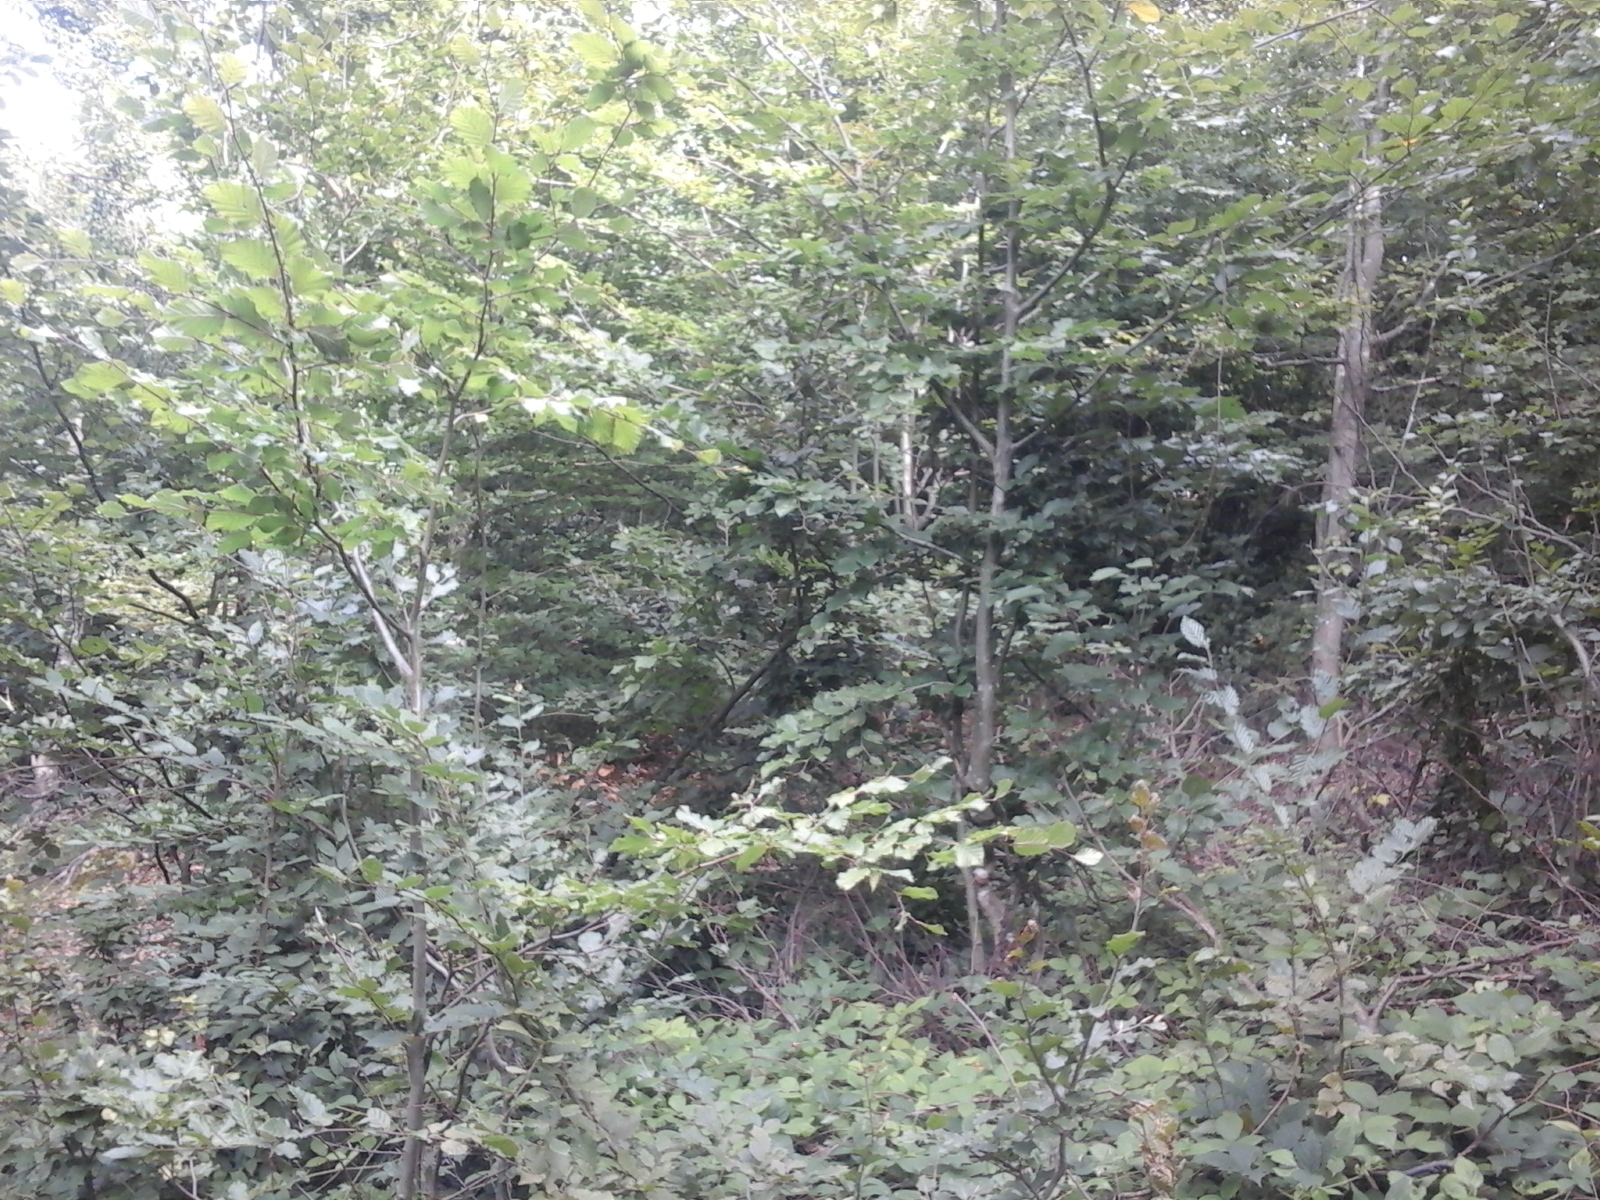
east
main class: Woodland
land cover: Broadleaved woodland
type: mesophytic deciduous forest
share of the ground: > 75 %
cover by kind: broadleaved forest trees 100 %
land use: Forestry
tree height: > 5 m
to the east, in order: Broadleaved woodland; Tracks; Broadleaved woodland
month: September
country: RO
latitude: 47.4512
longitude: 23.7253
